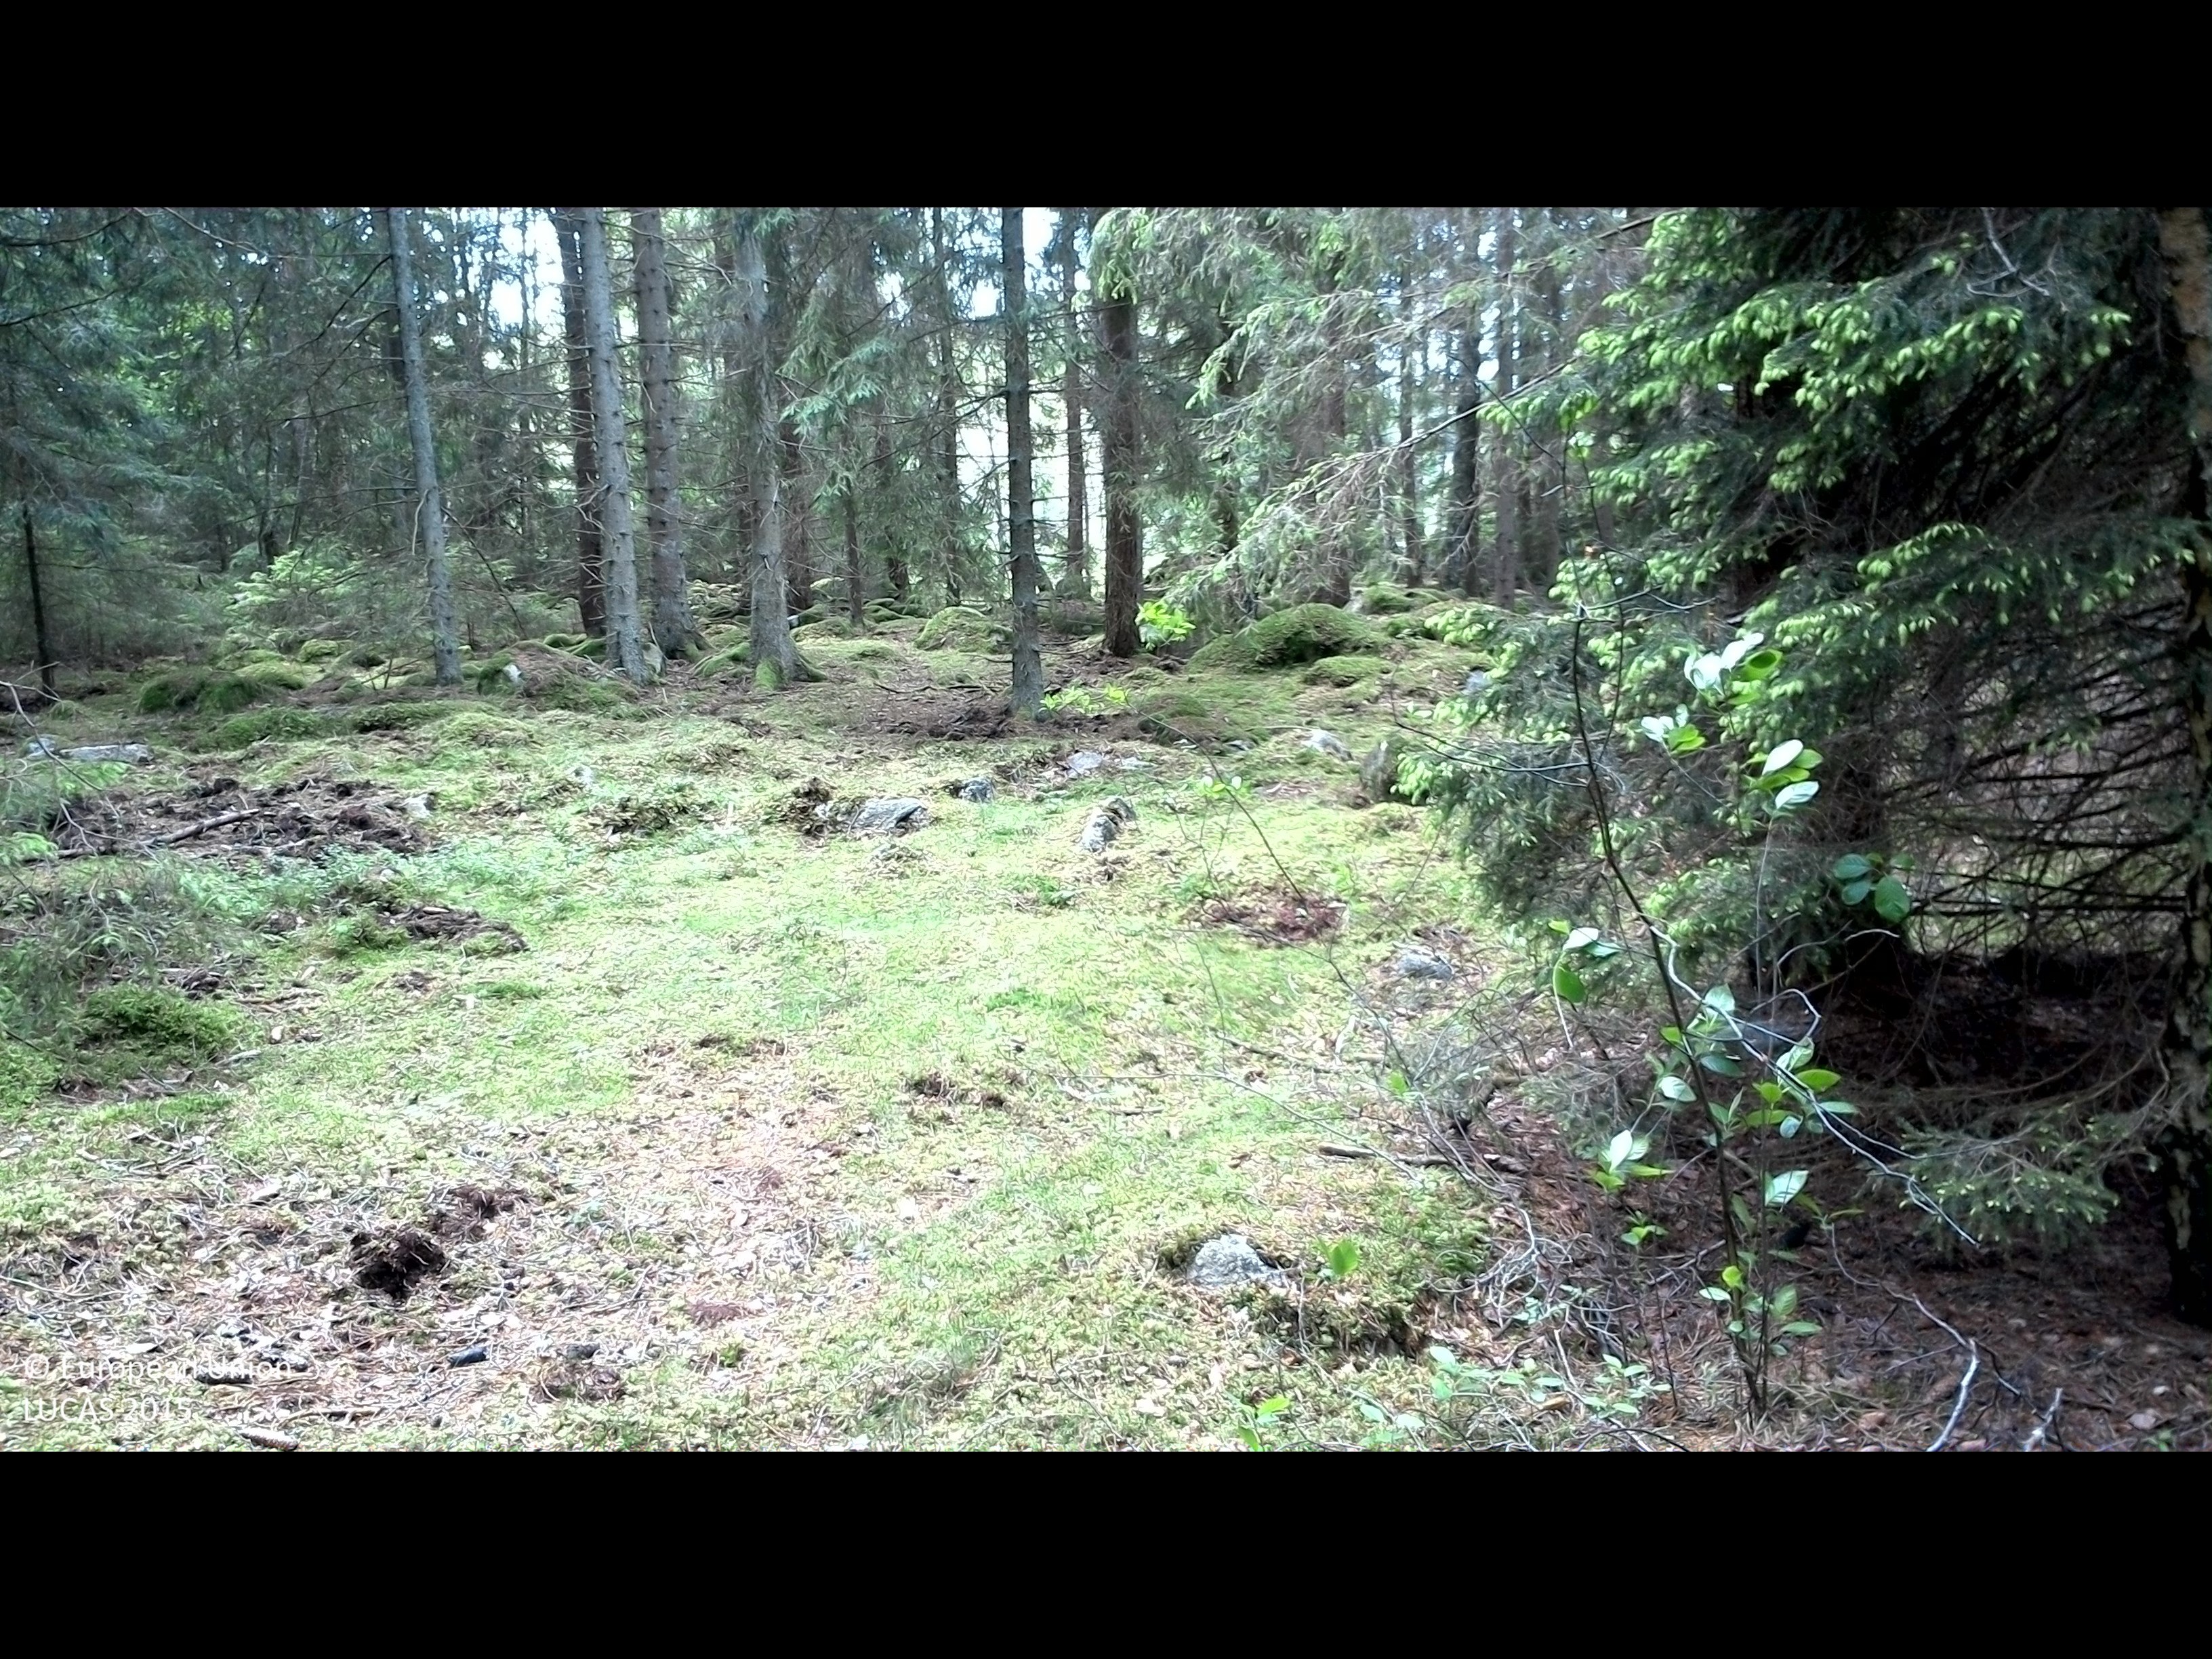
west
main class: Woodland
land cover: Spruce dominated coniferous woodland
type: boreal forest
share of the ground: > 75 %
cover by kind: coniferous forest trees 75 %, lichens and mosses 15 %, broadleaved forest trees 10 %
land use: Forestry
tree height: > 5 m
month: June
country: SE
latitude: 56.4314
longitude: 15.8865
